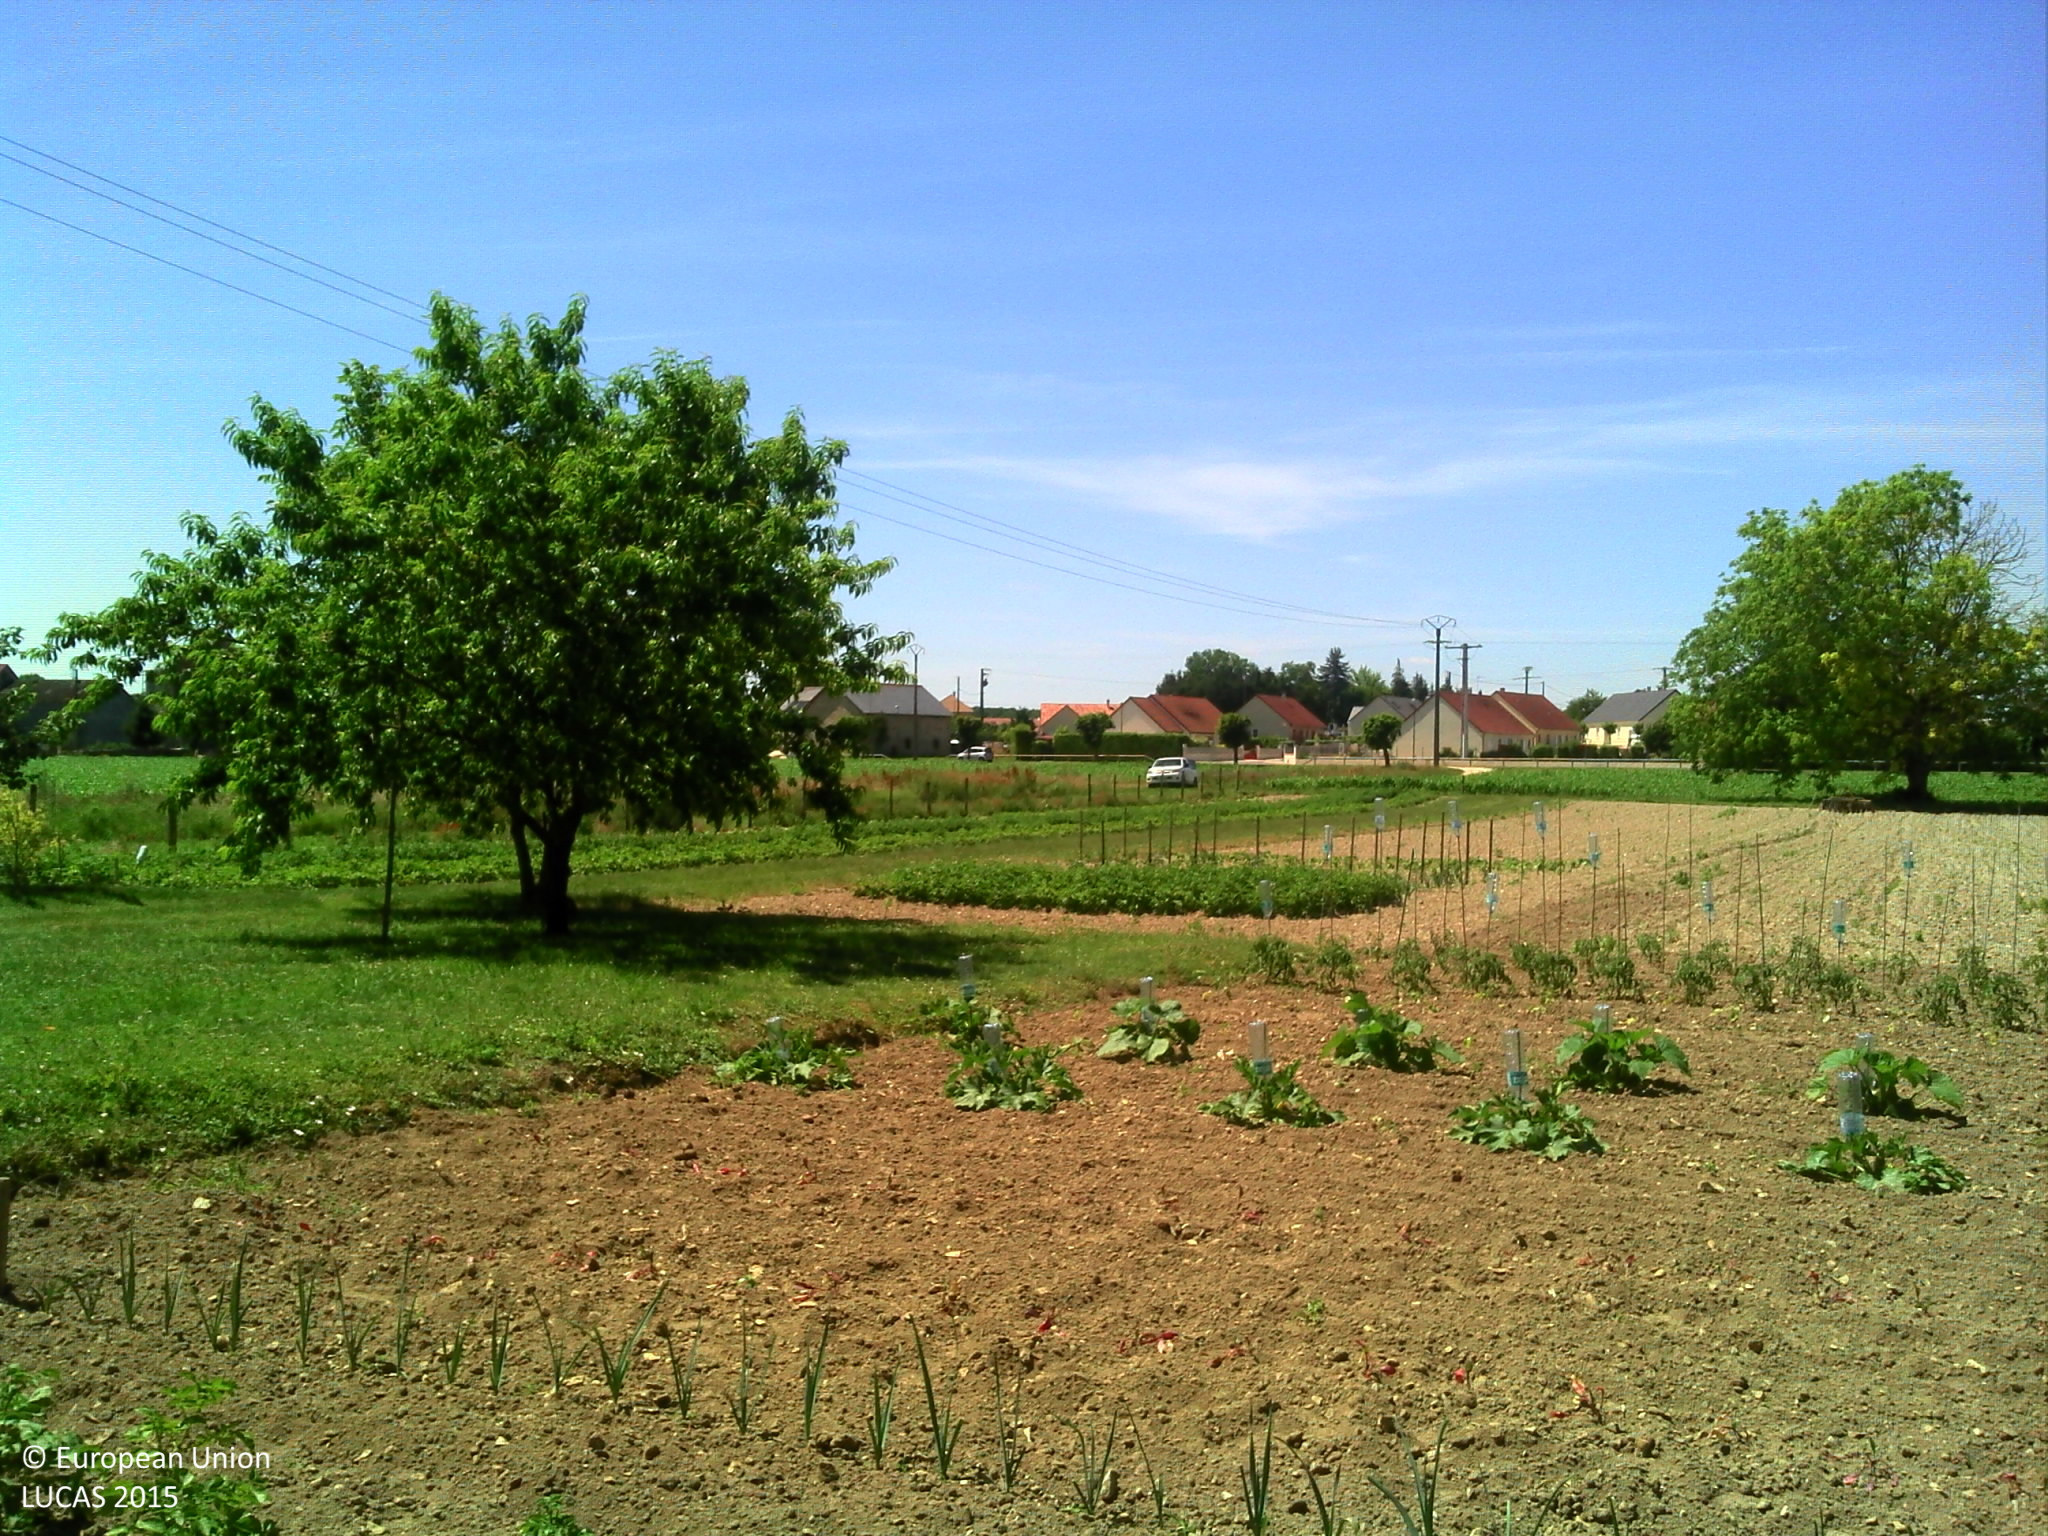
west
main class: Cropland
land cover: Other fresh vegetables
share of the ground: > 75 %
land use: Kitchen garden
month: June
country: FR
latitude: 47.1270
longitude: 2.6247
